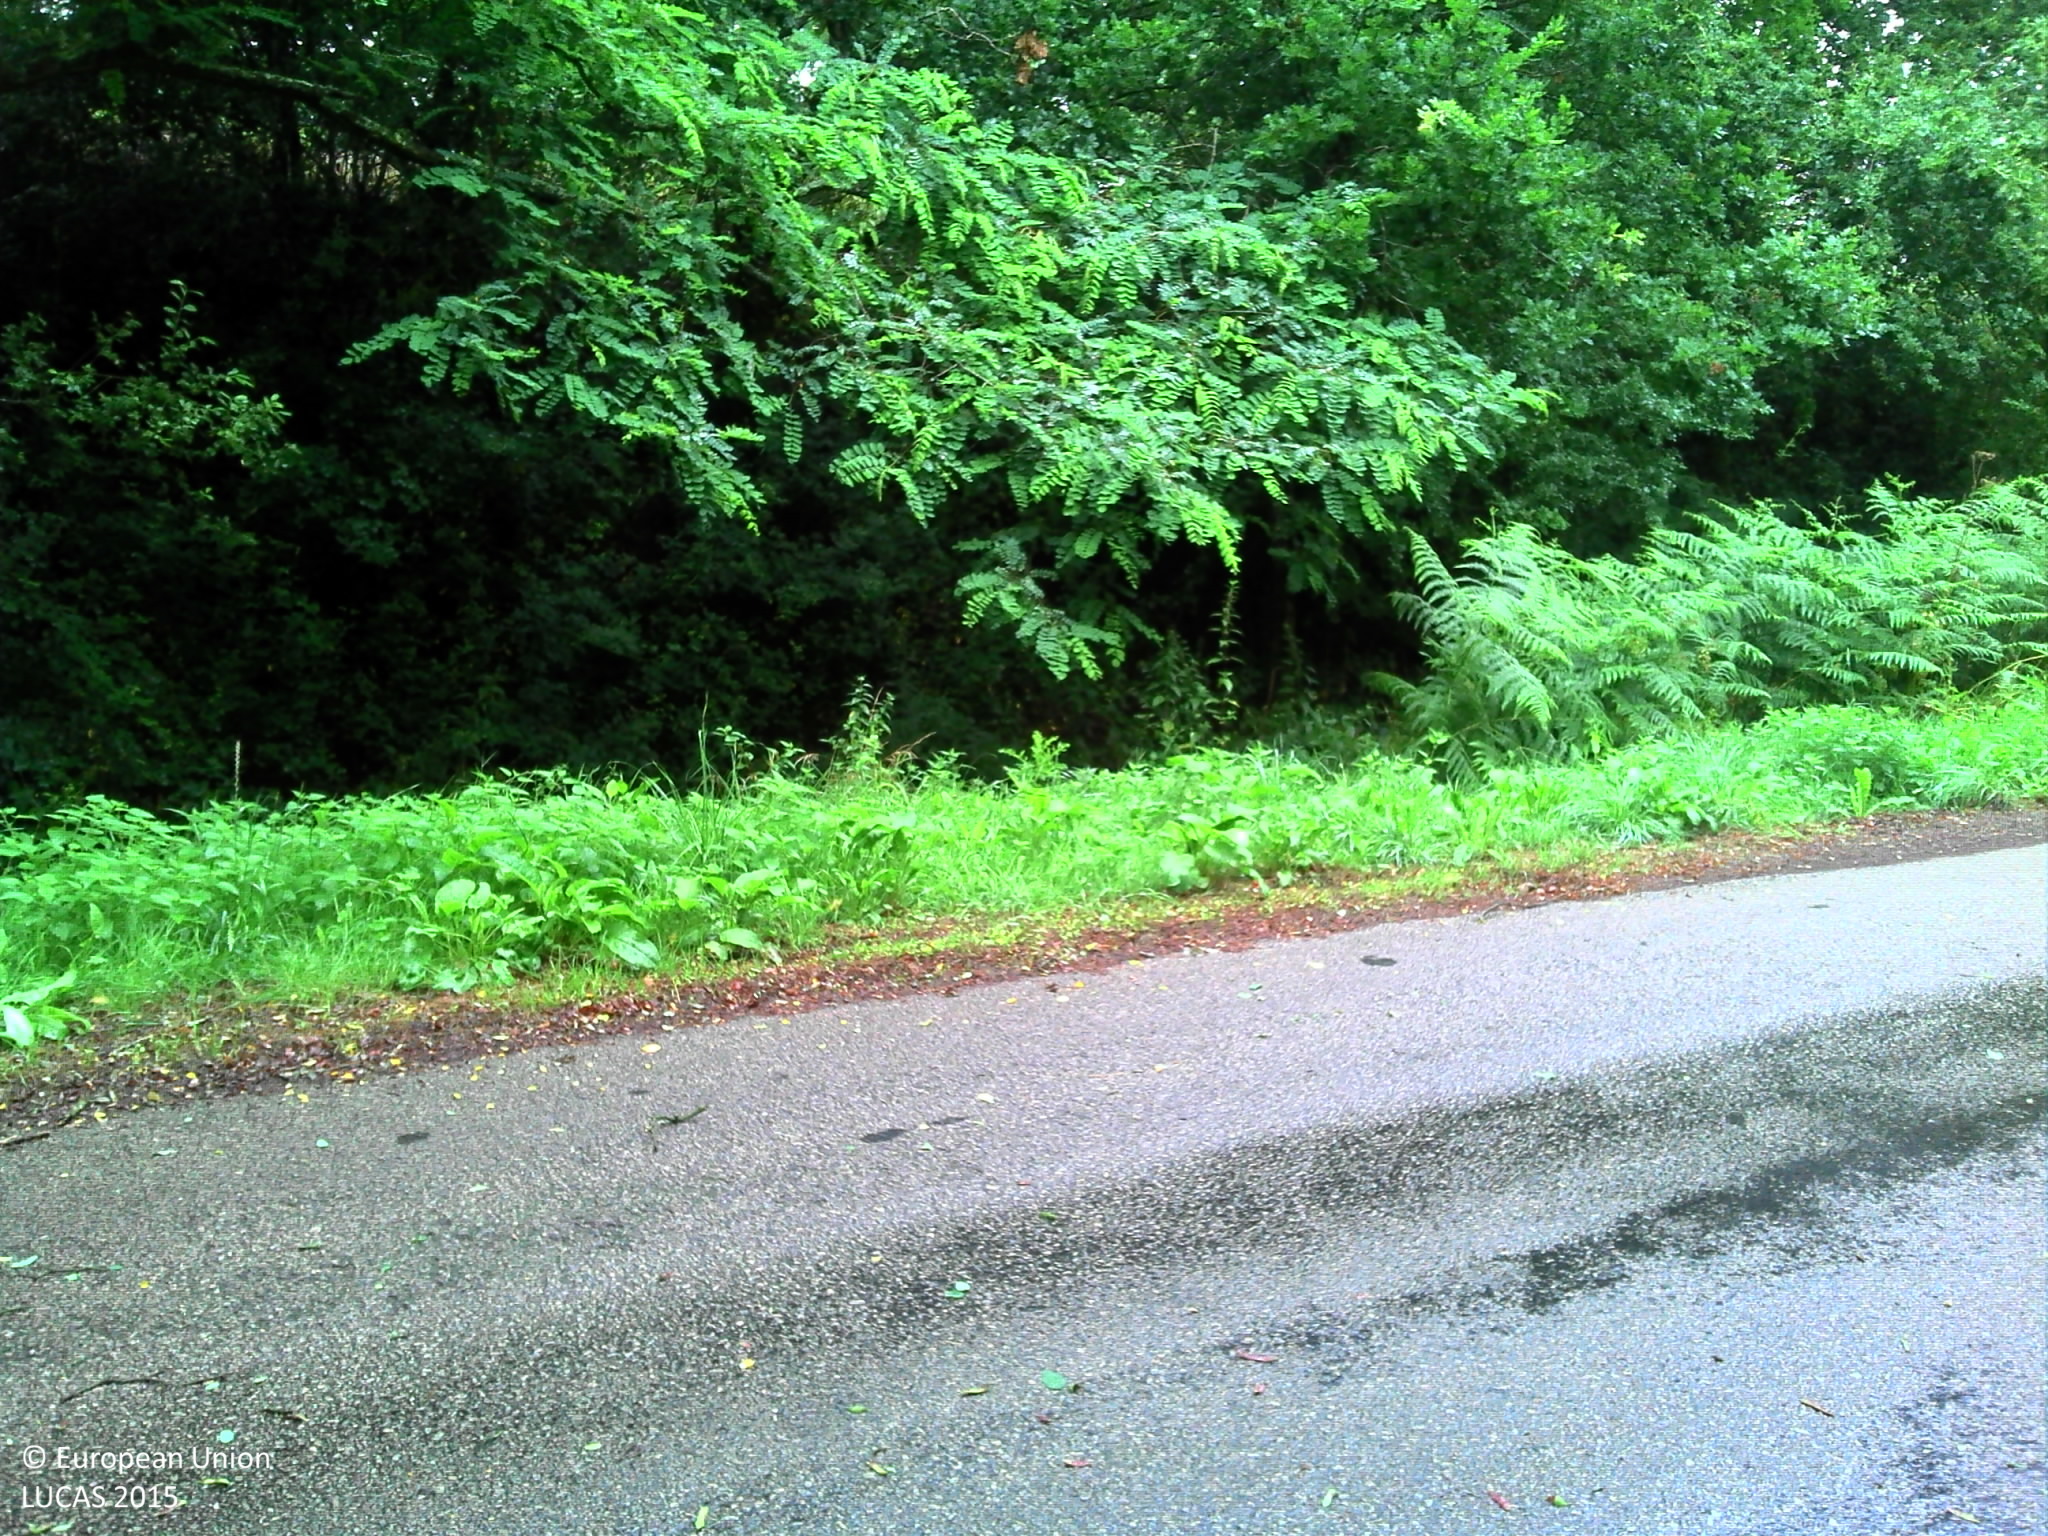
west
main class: Woodland
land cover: Broadleaved woodland
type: acidophilous oak and oak-birch forest
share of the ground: > 75 %
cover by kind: broadleaved forest trees 60 %, shrubs 15 %, herbaceous plants 15 %, consolidated bare surface 10 %
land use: Forestry
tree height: > 5 m
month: July
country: FR
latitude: 47.7477
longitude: -3.0992
